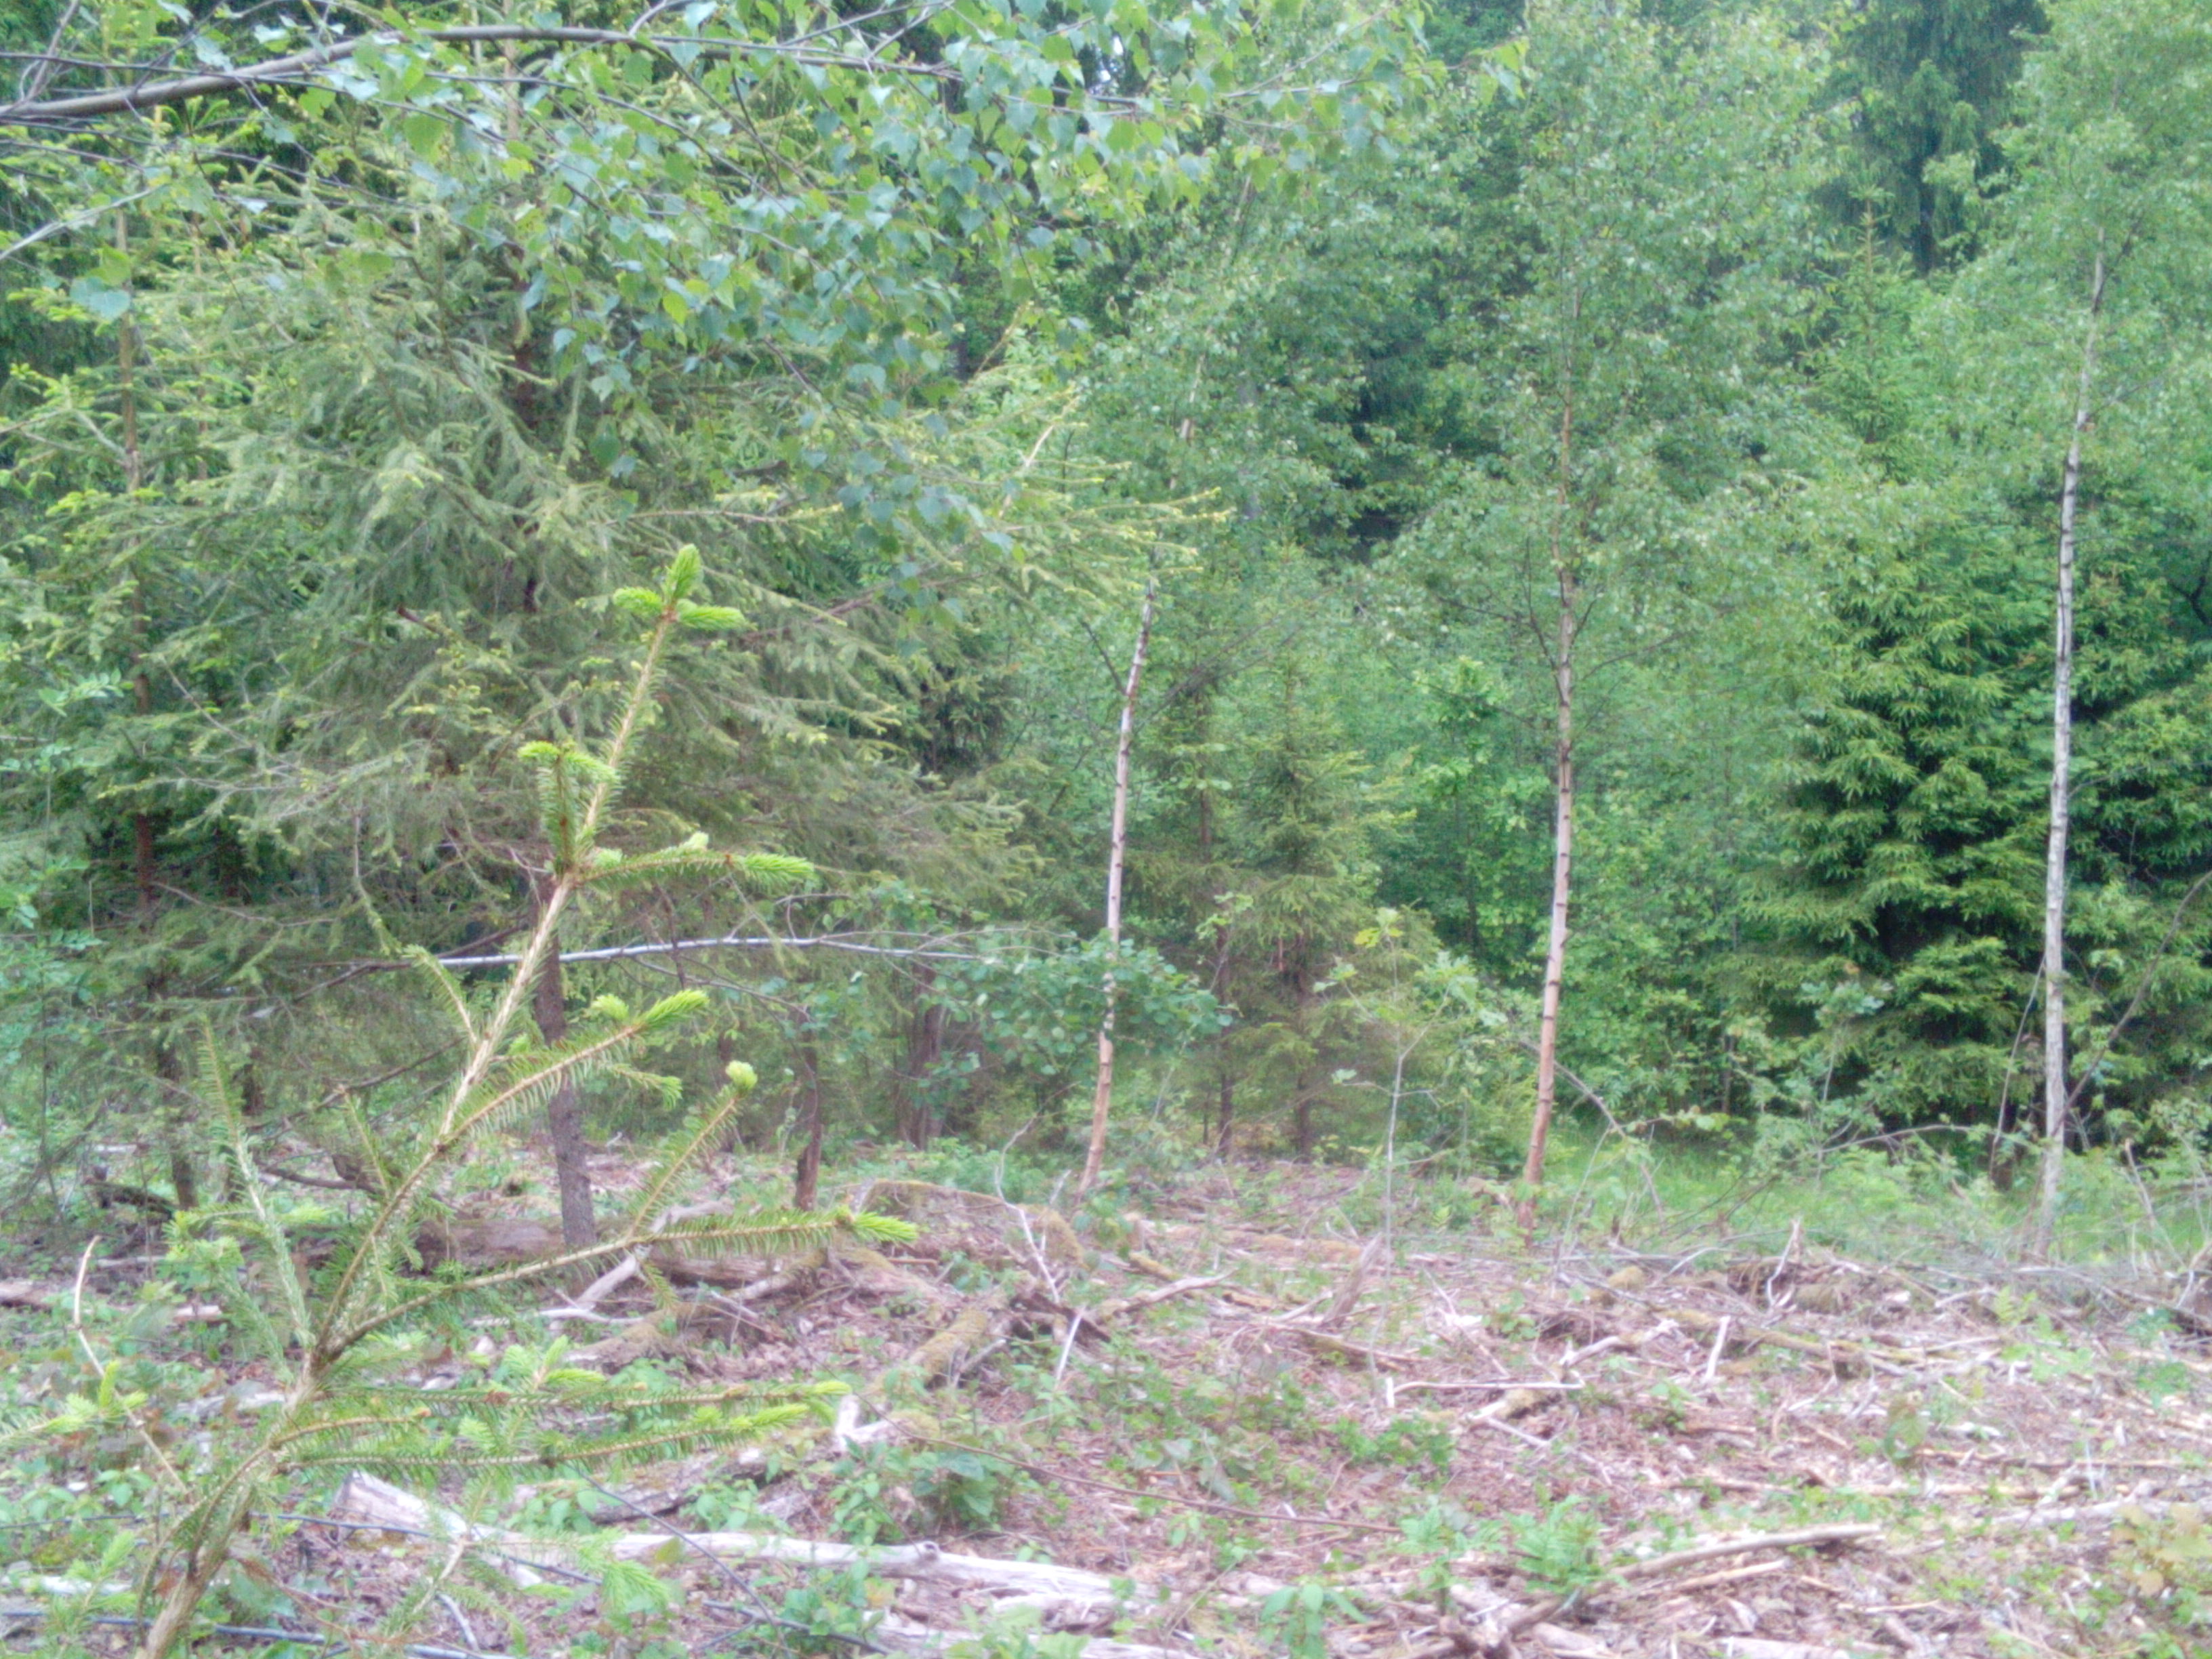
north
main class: Woodland
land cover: Spruce dominated mixed woodland
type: hemiboreal forest and nemoral coniferous forest and mixed broadleaved-coniferous forest
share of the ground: 25 - 50 %
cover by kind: herbaceous plants 35 %, coniferous forest trees 25 %, broadleaved forest trees 20 %, shrubs 15 %
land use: Forestry
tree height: > 5 m
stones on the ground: 10 - 25 %
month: June
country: LV
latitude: 56.8509
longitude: 21.9016
